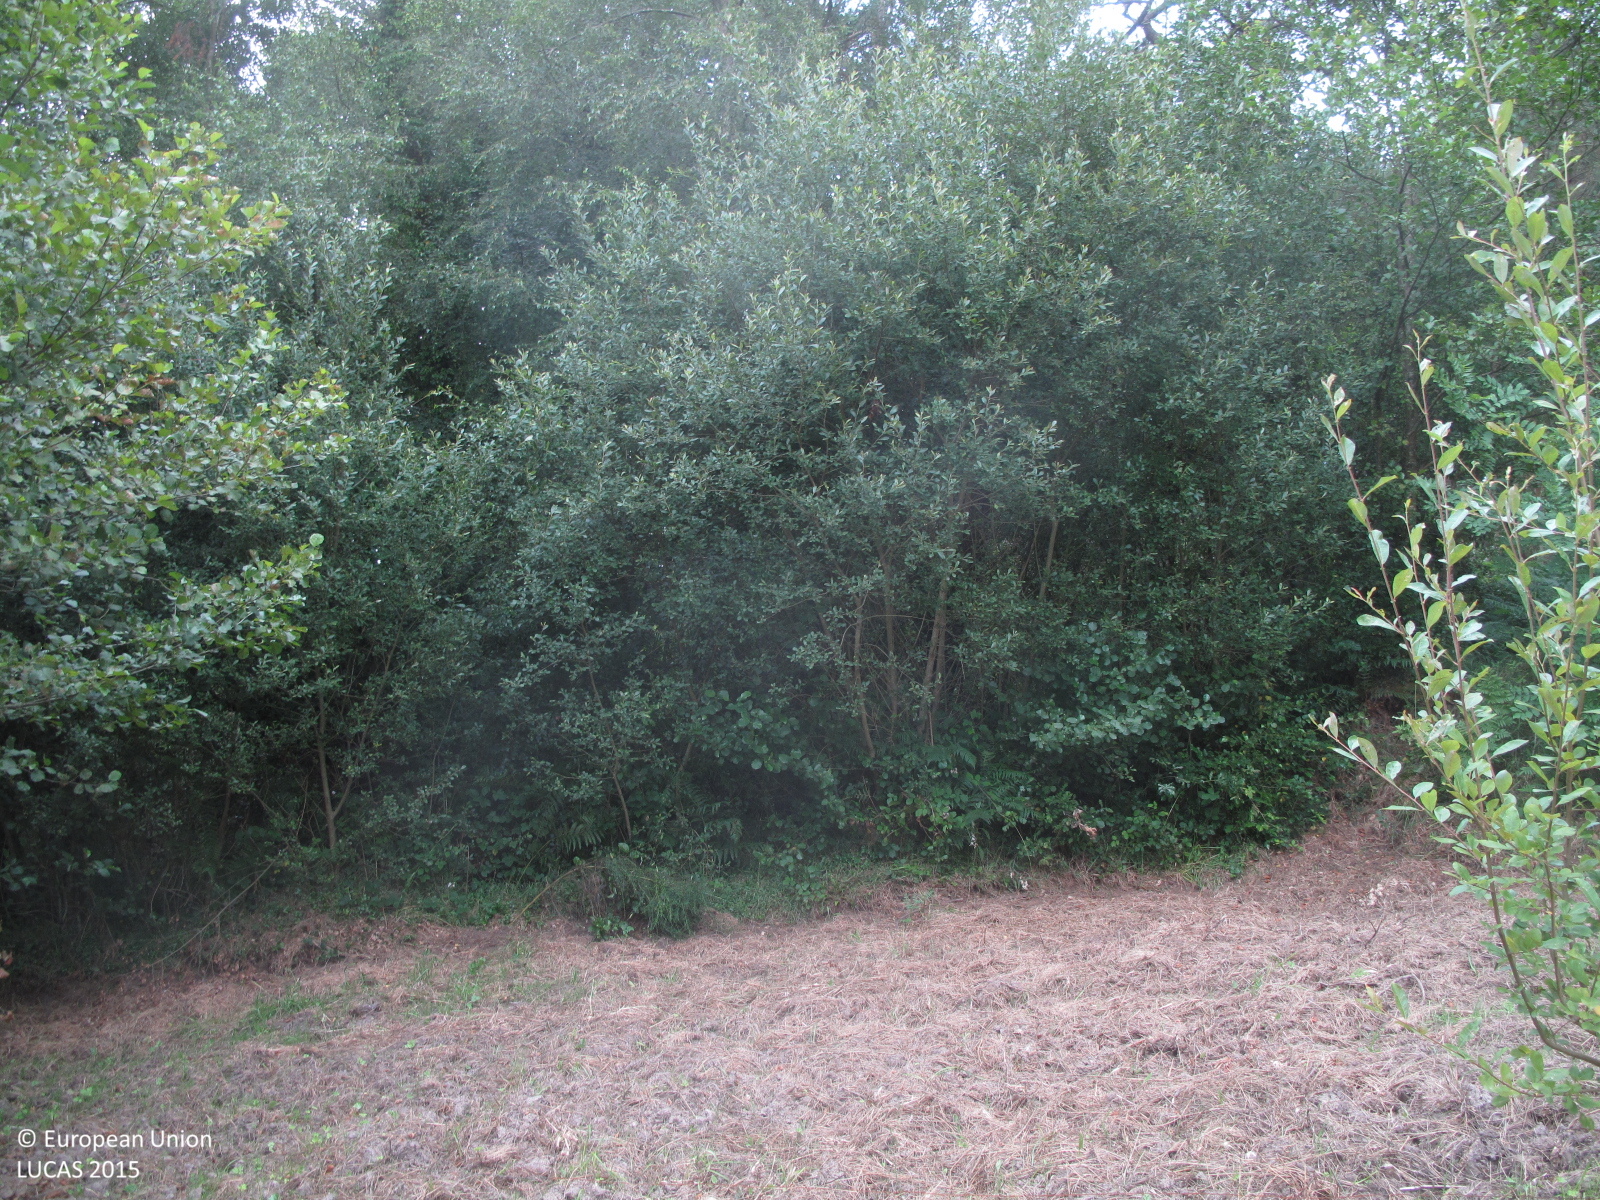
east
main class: Grassland
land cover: Grassland without tree/shrub cover
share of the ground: > 75 %
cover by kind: herbaceous plants 80 %, unconsolidated bare surface 20 %
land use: Agriculture (excluding fallow land and kitchen gardens)
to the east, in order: Grassland without tree/shrub cover; Broadleaved woodland; Pine dominated coniferous woodland; Broadleaved woodland; Paved roads, cycling and walking lanes; Broadleaved woodland; Tracks; Broadleaved woodland; Shrubland with sparse tree cover; Broadleaved woodland
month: July
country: ES
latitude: 43.2293
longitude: -8.5668
